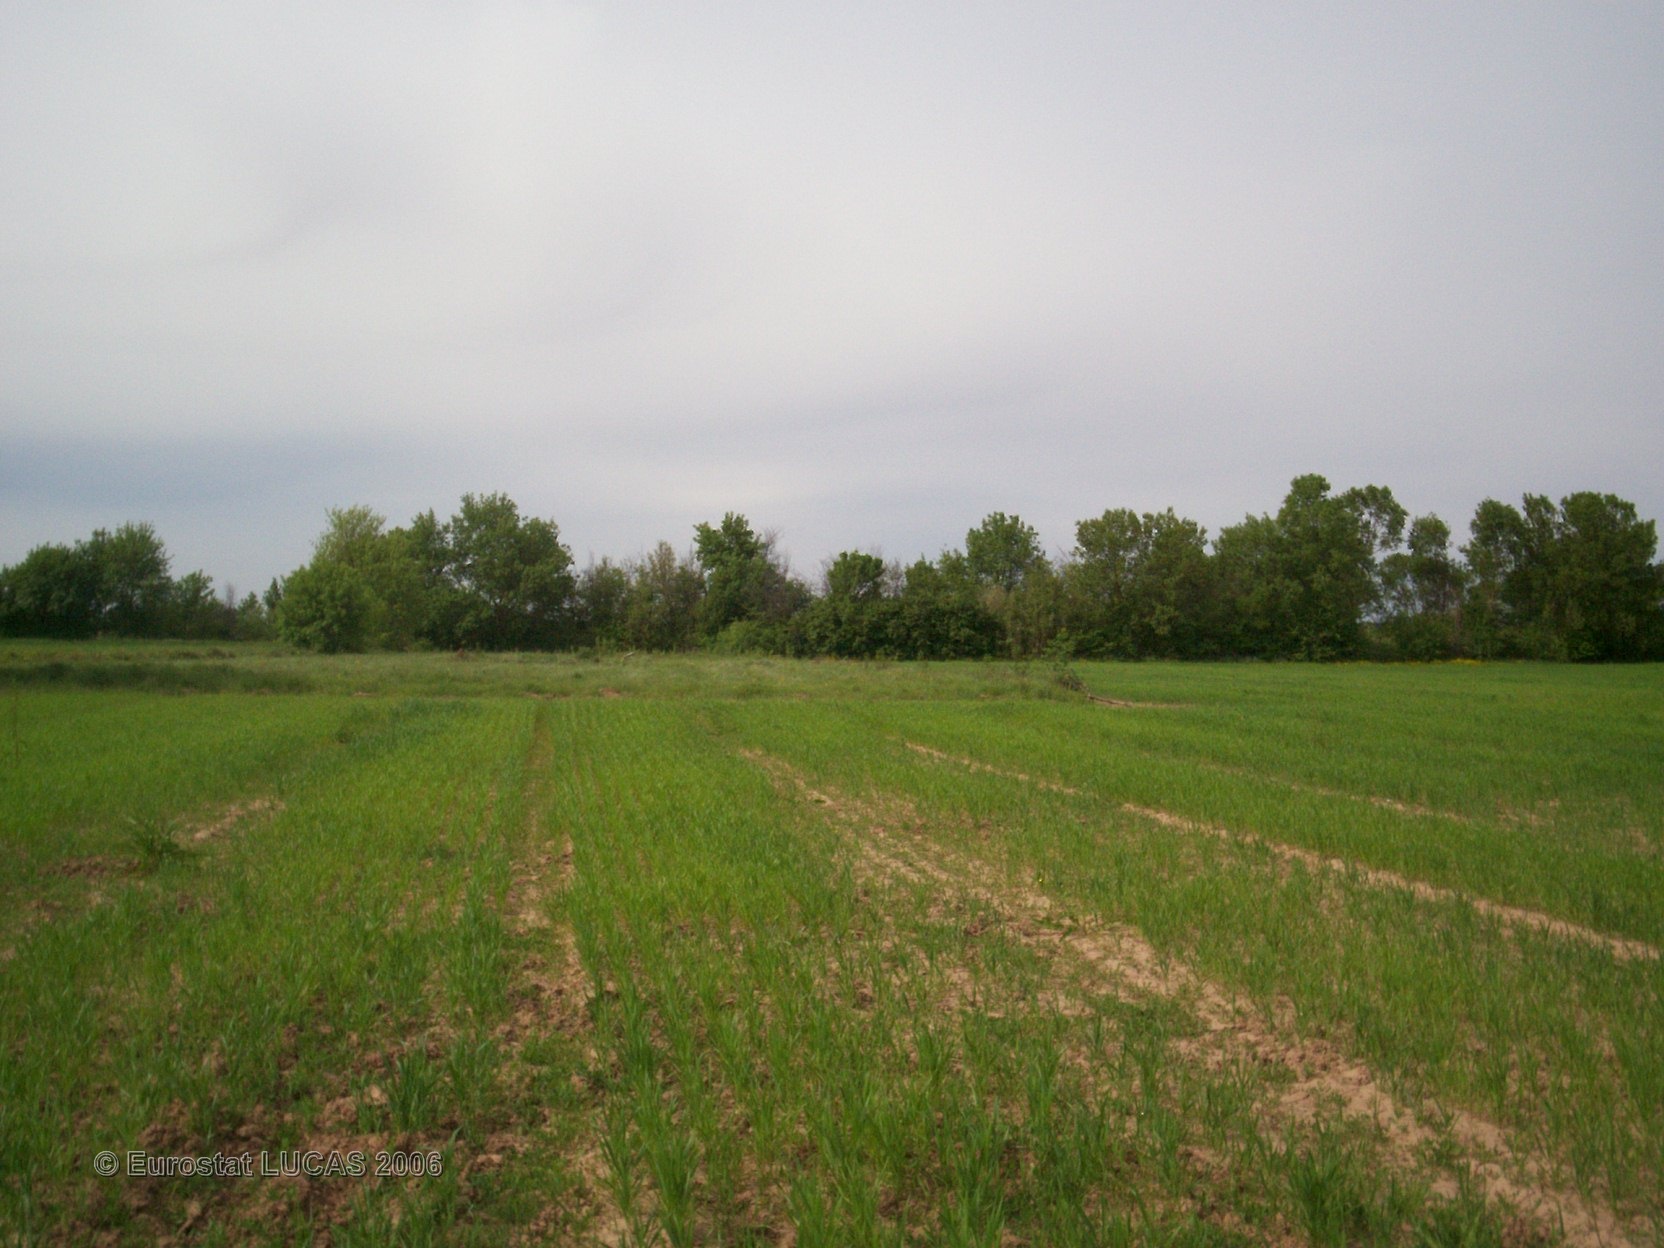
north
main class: Cropland
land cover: Barley
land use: Agriculture (excluding fallow land and kitchen gardens)
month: April
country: FR
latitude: 43.3659
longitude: 3.4570
